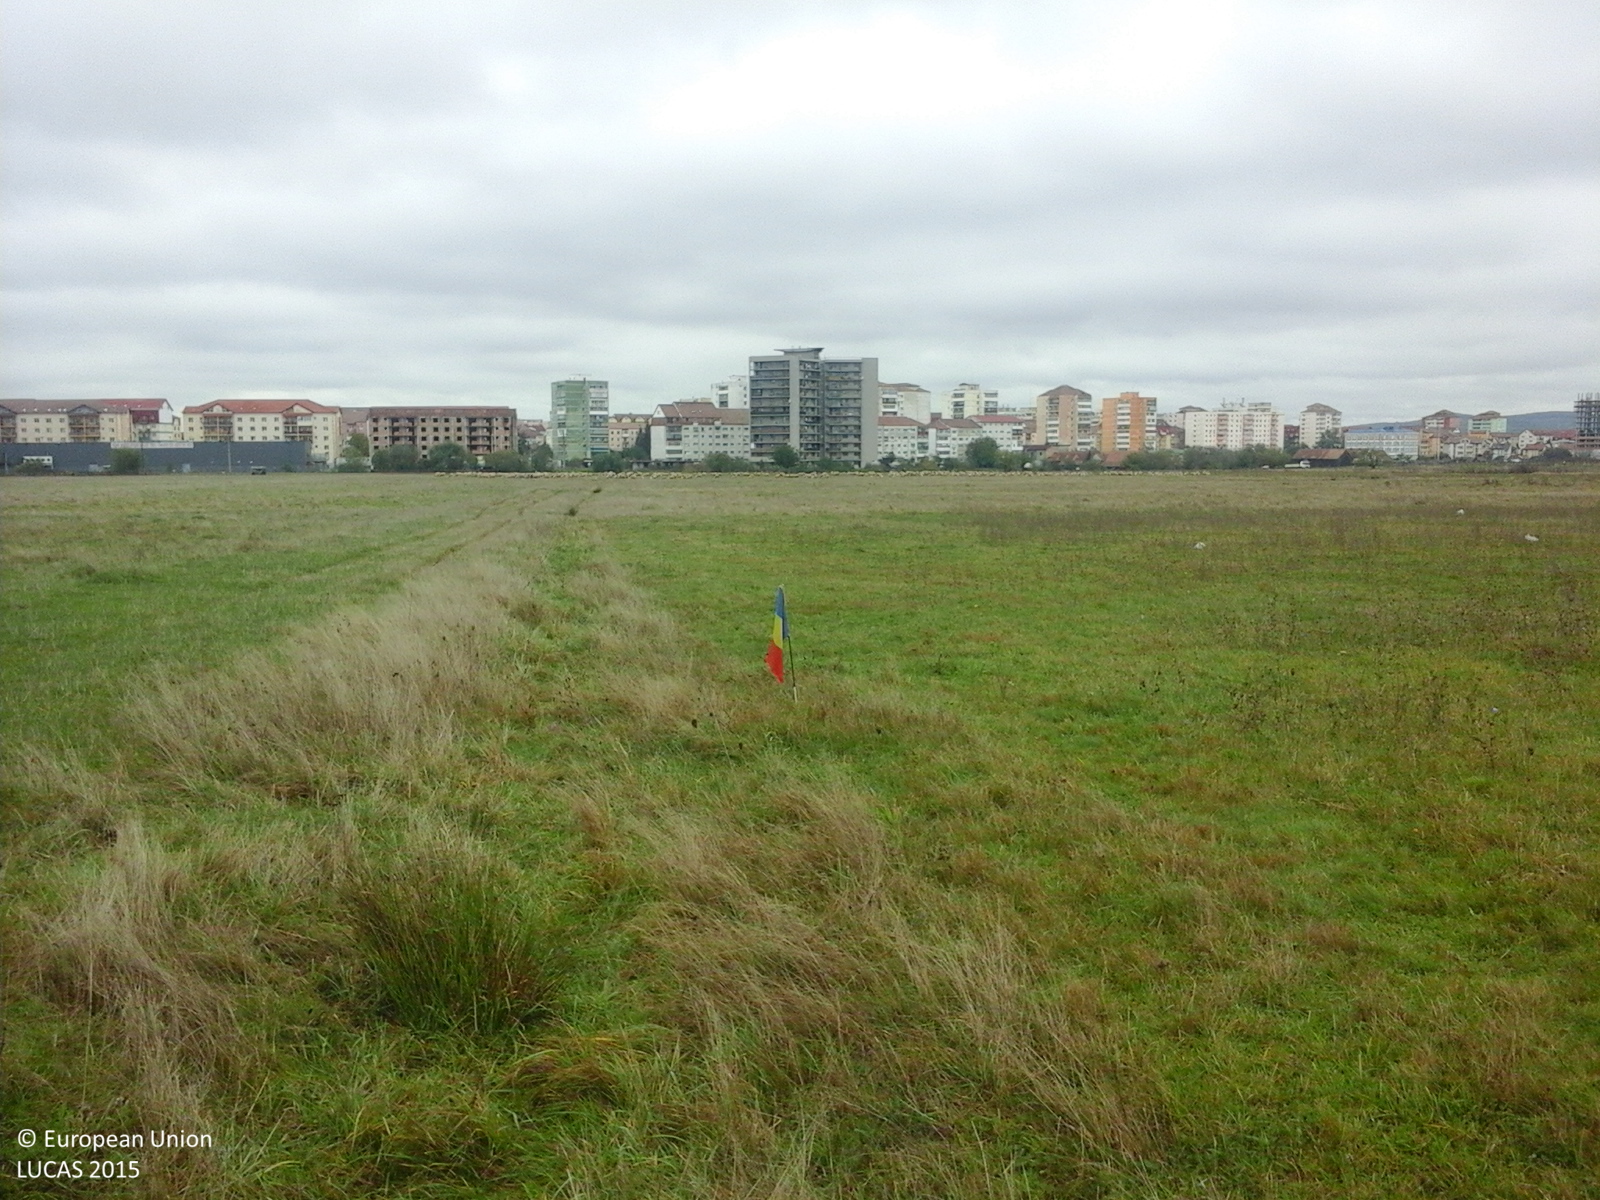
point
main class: Grassland
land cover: Grassland without tree/shrub cover
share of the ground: > 75 %
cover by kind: herbaceous plants 100 %
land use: Agriculture (excluding fallow land and kitchen gardens)
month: October
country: RO
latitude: 45.7695
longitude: 24.1555
